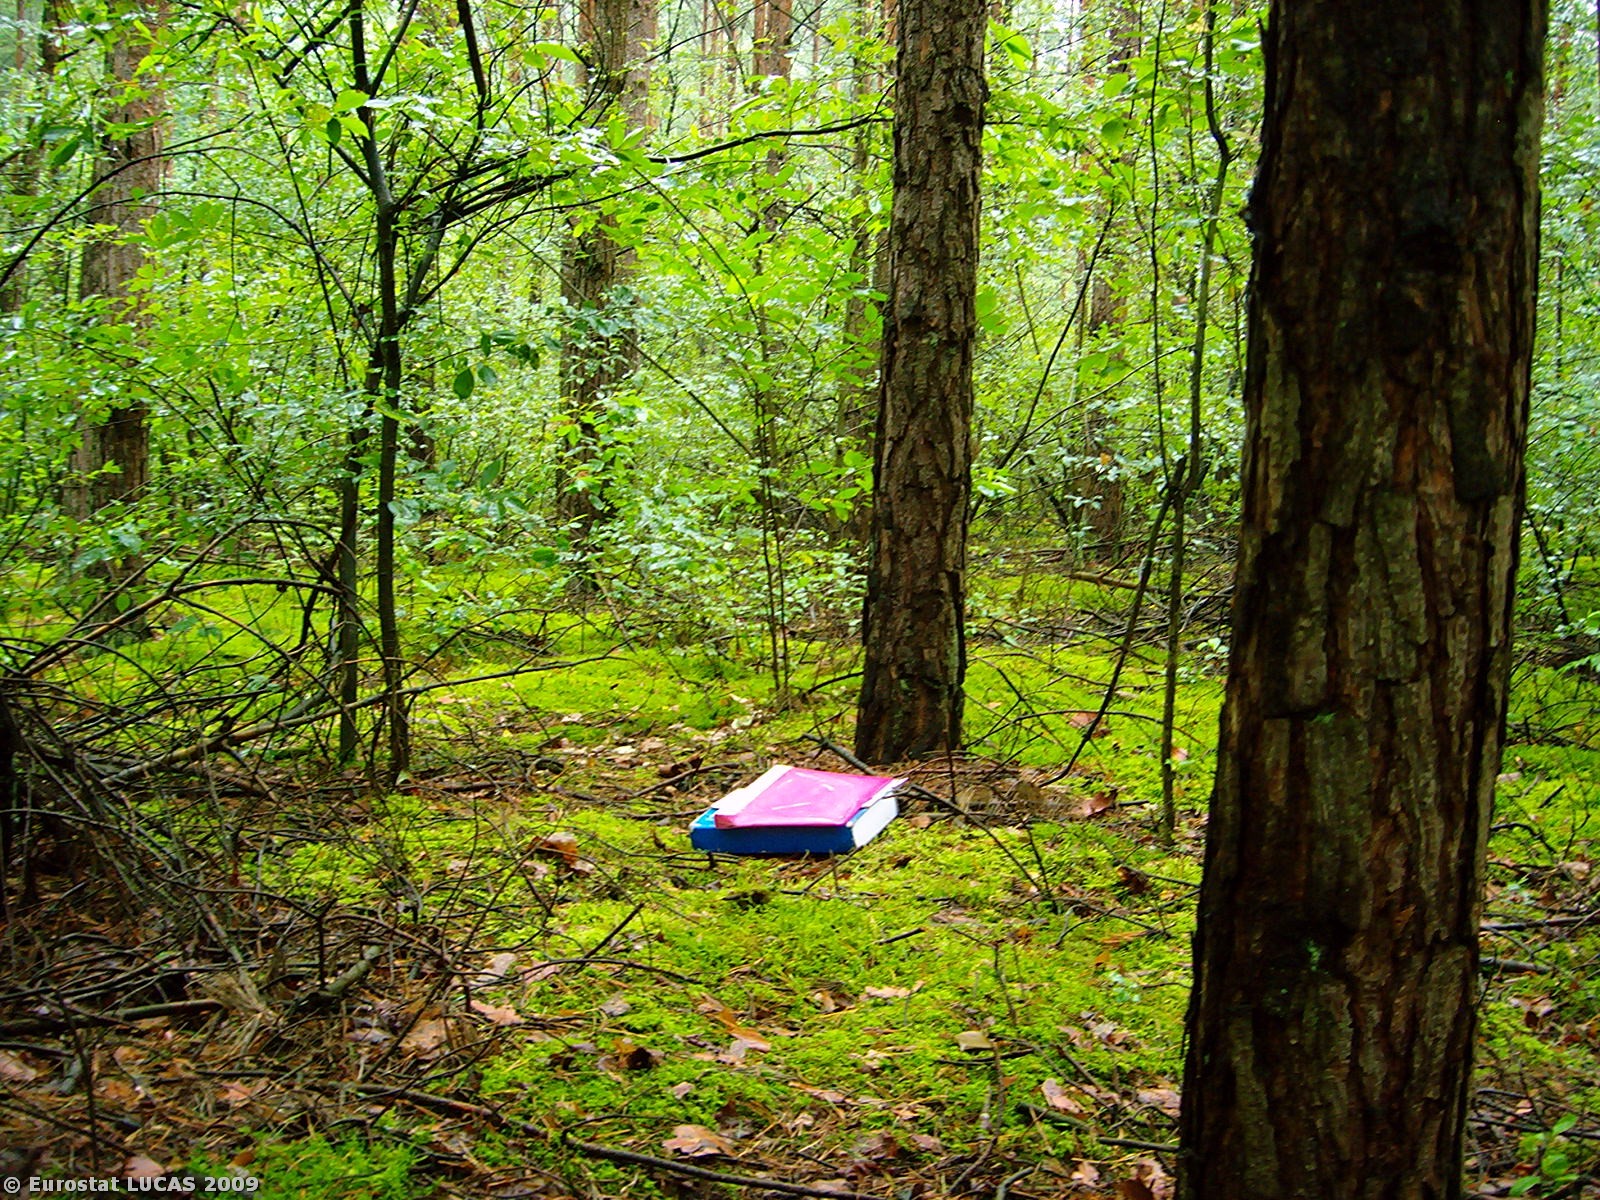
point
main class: Woodland
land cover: Mixed woodland
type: hemiboreal forest and nemoral coniferous forest and mixed broadleaved-coniferous forest
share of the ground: > 75 %
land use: Forestry
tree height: > 5 m
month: July
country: PL
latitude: 52.6768
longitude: 15.2241
